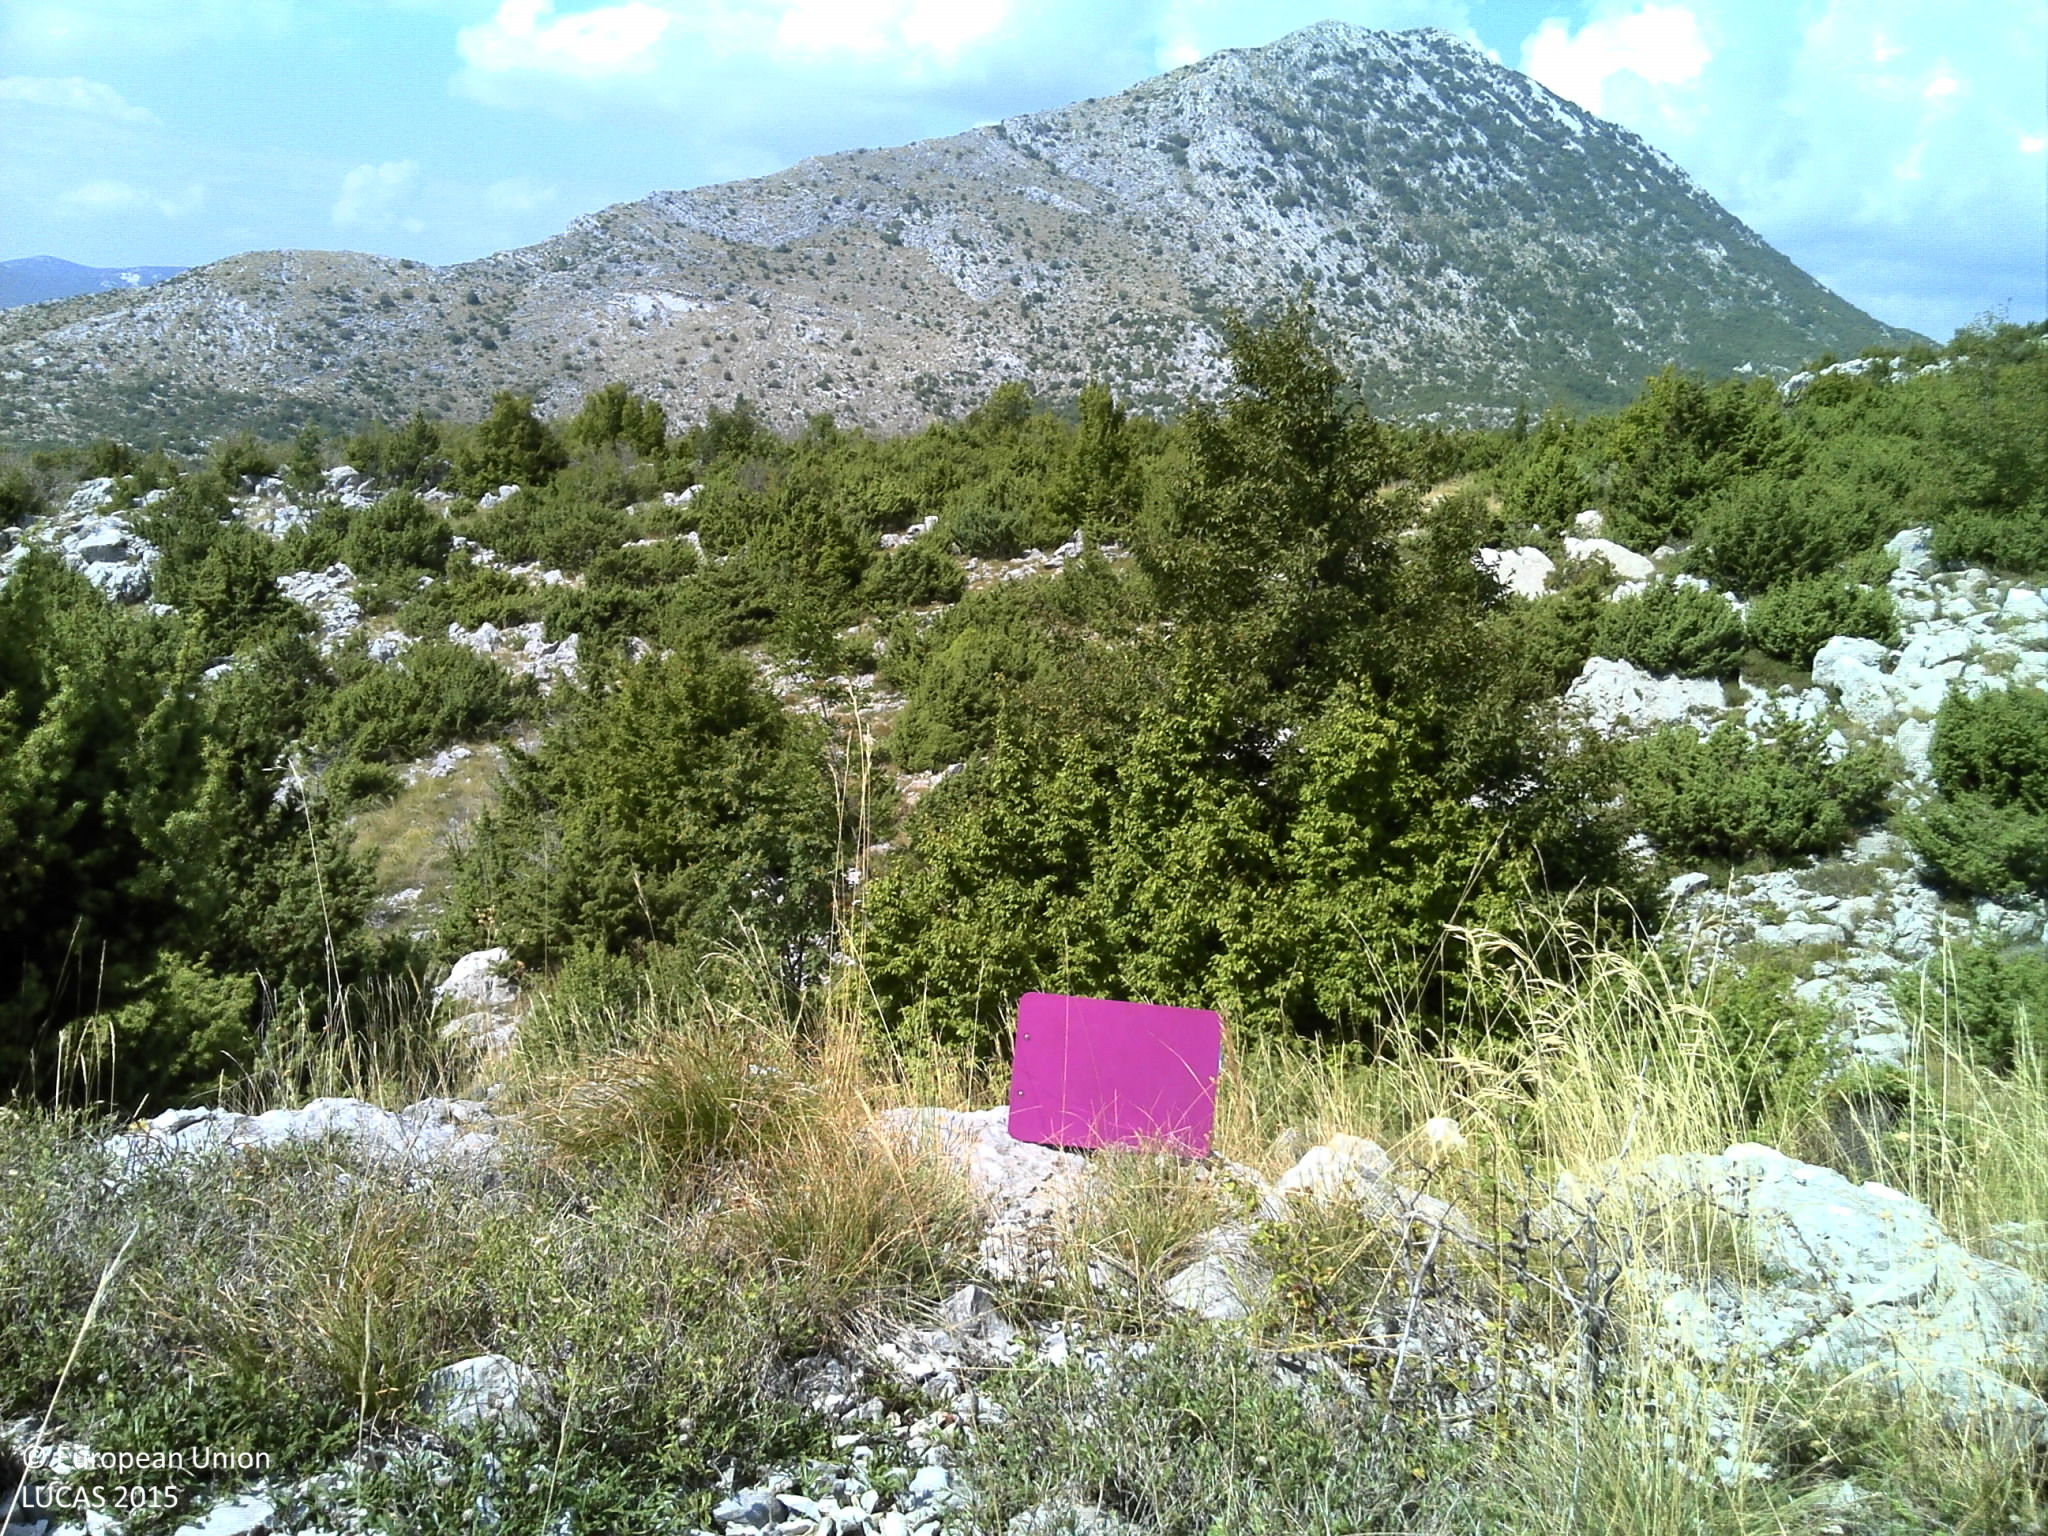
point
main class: Shrubland
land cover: Shrubland with sparse tree cover
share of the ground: > 75 %
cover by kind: shrubs 45 %, unconsolidated bare surface 25 %, herbaceous plants 20 %, coniferous forest trees 5 %, consolidated bare surface 5 %
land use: Semi-natural and natural areas not in use
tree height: < 5 m
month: August
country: HR
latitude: 43.2622
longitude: 17.2719
